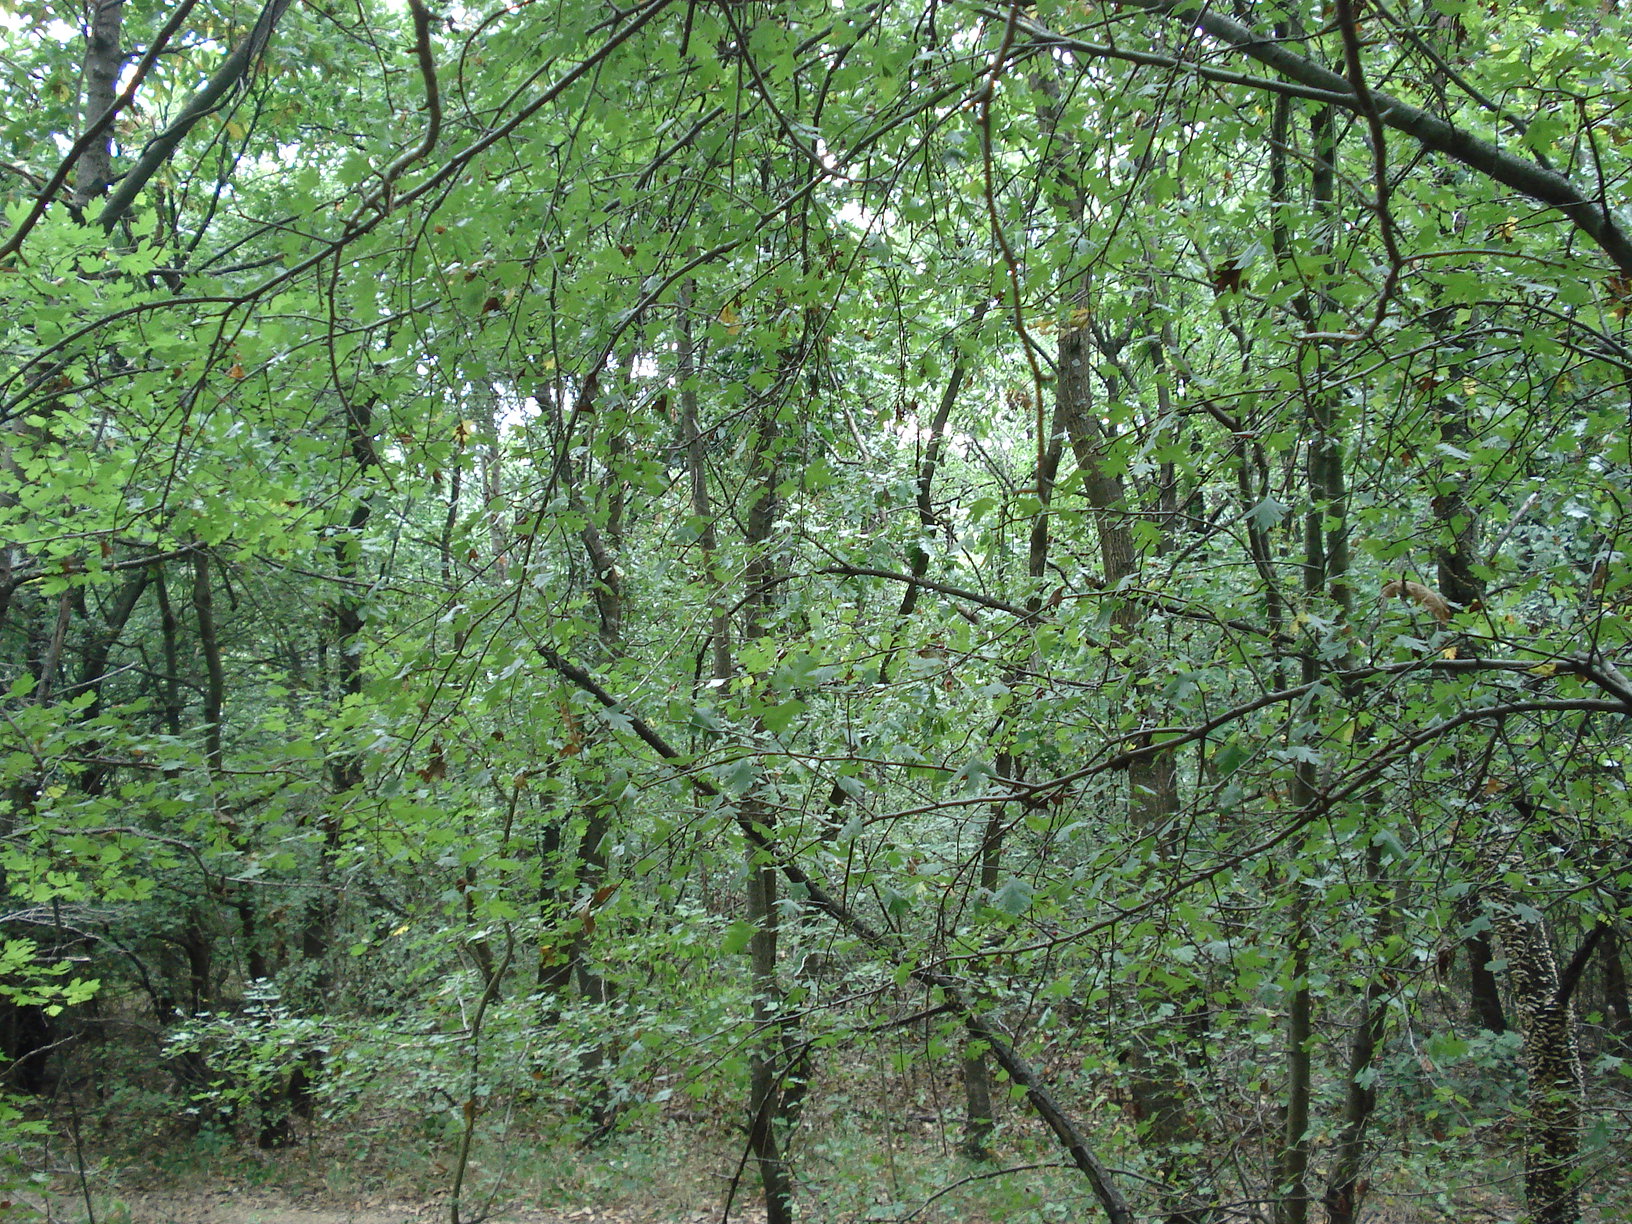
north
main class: Woodland
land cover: Broadleaved woodland
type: mesophytic deciduous forest
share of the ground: > 75 %
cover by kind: broadleaved forest trees 85 %, herbaceous plants 10 %, shrubs 5 %
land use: Forestry
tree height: > 5 m
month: September
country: BG
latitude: 43.0456
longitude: 25.7583
